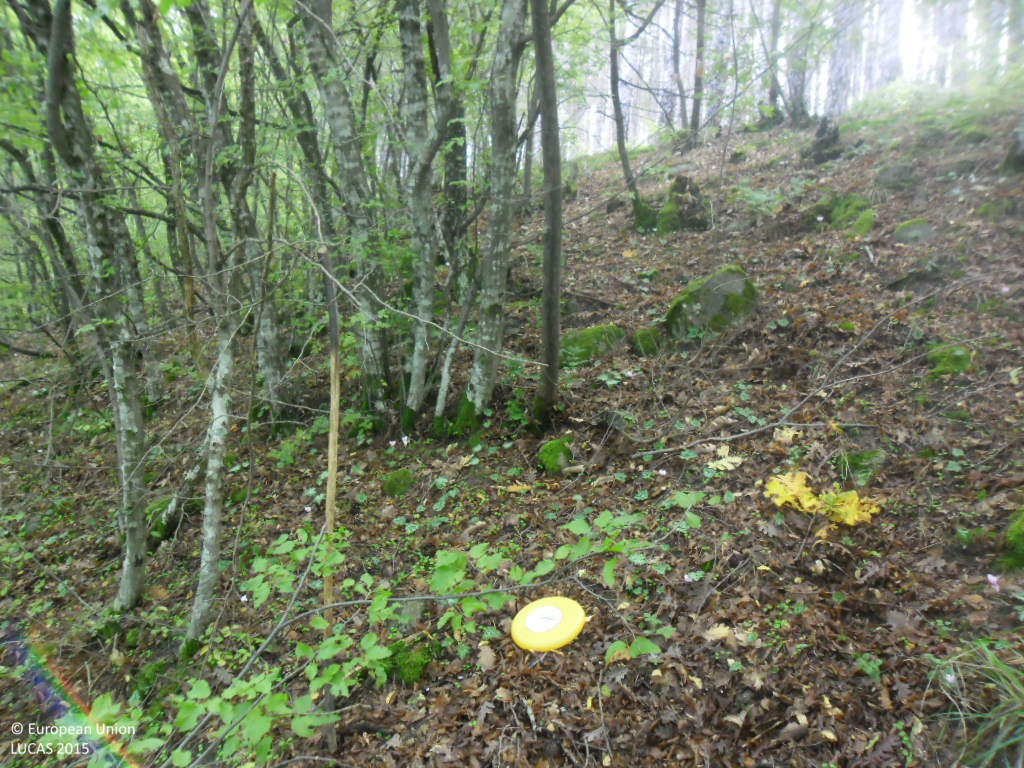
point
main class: Woodland
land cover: Pine dominated mixed woodland
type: hemiboreal forest and nemoral coniferous forest and mixed broadleaved-coniferous forest
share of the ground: > 75 %
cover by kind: coniferous forest trees 75 %, broadleaved forest trees 25 %
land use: Forestry
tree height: > 5 m
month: October
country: BG
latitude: 41.7442
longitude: 23.2385
